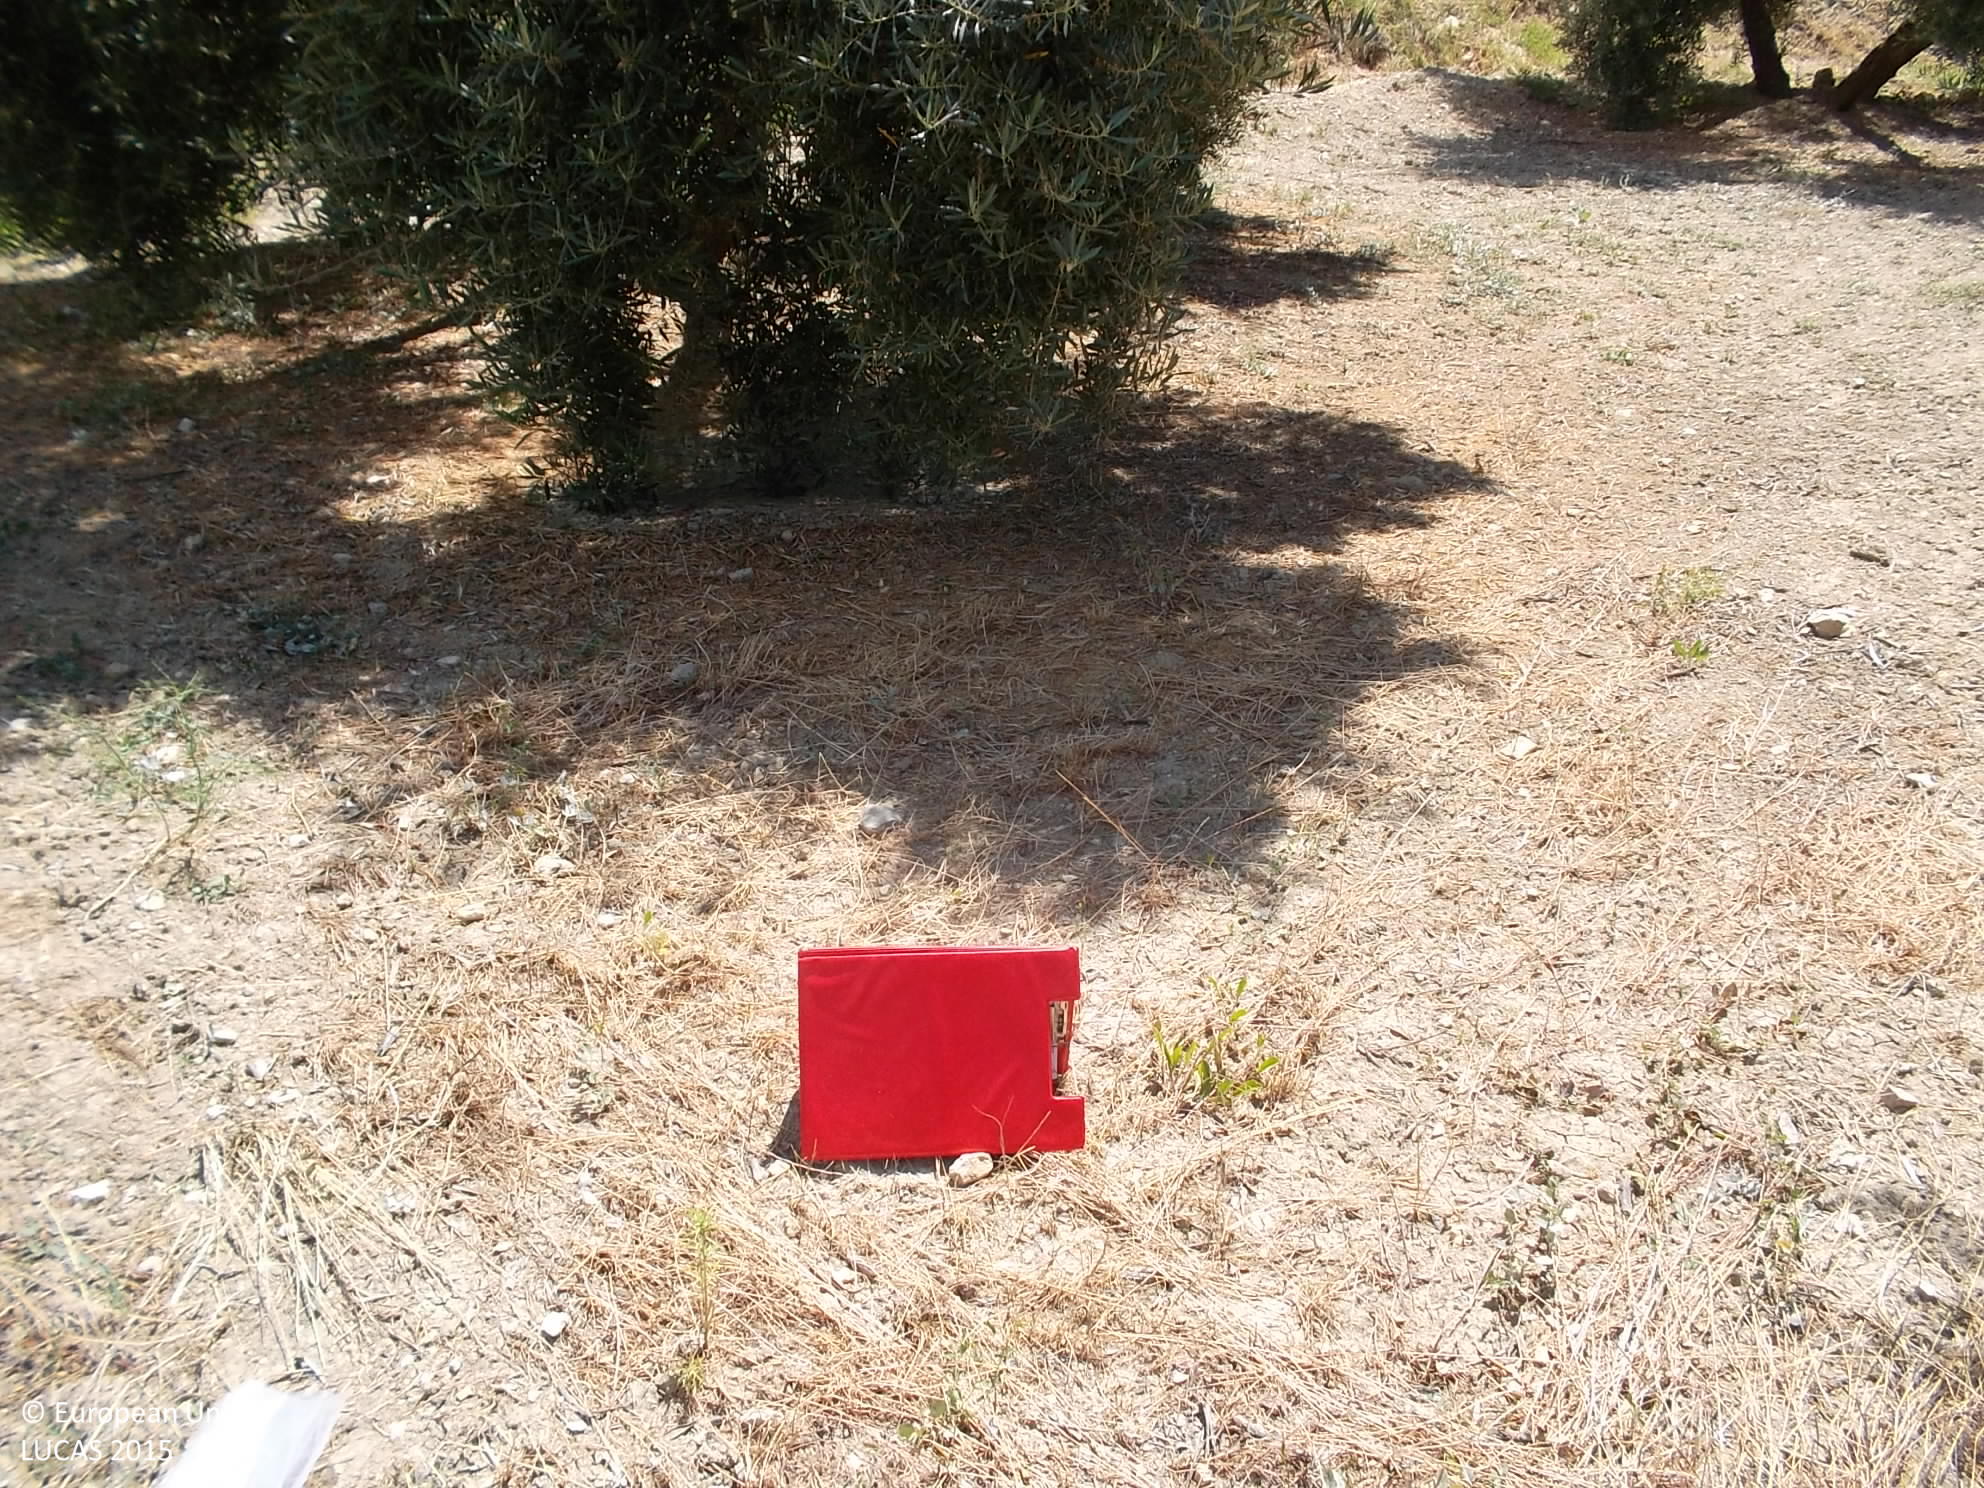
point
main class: Cropland
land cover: Olive groves
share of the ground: 25 - 50 %
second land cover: Other bare soil
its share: > 75 %
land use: Agriculture (excluding fallow land and kitchen gardens)
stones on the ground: < 10 %
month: June
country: ES
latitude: 37.9570
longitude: -2.9587
